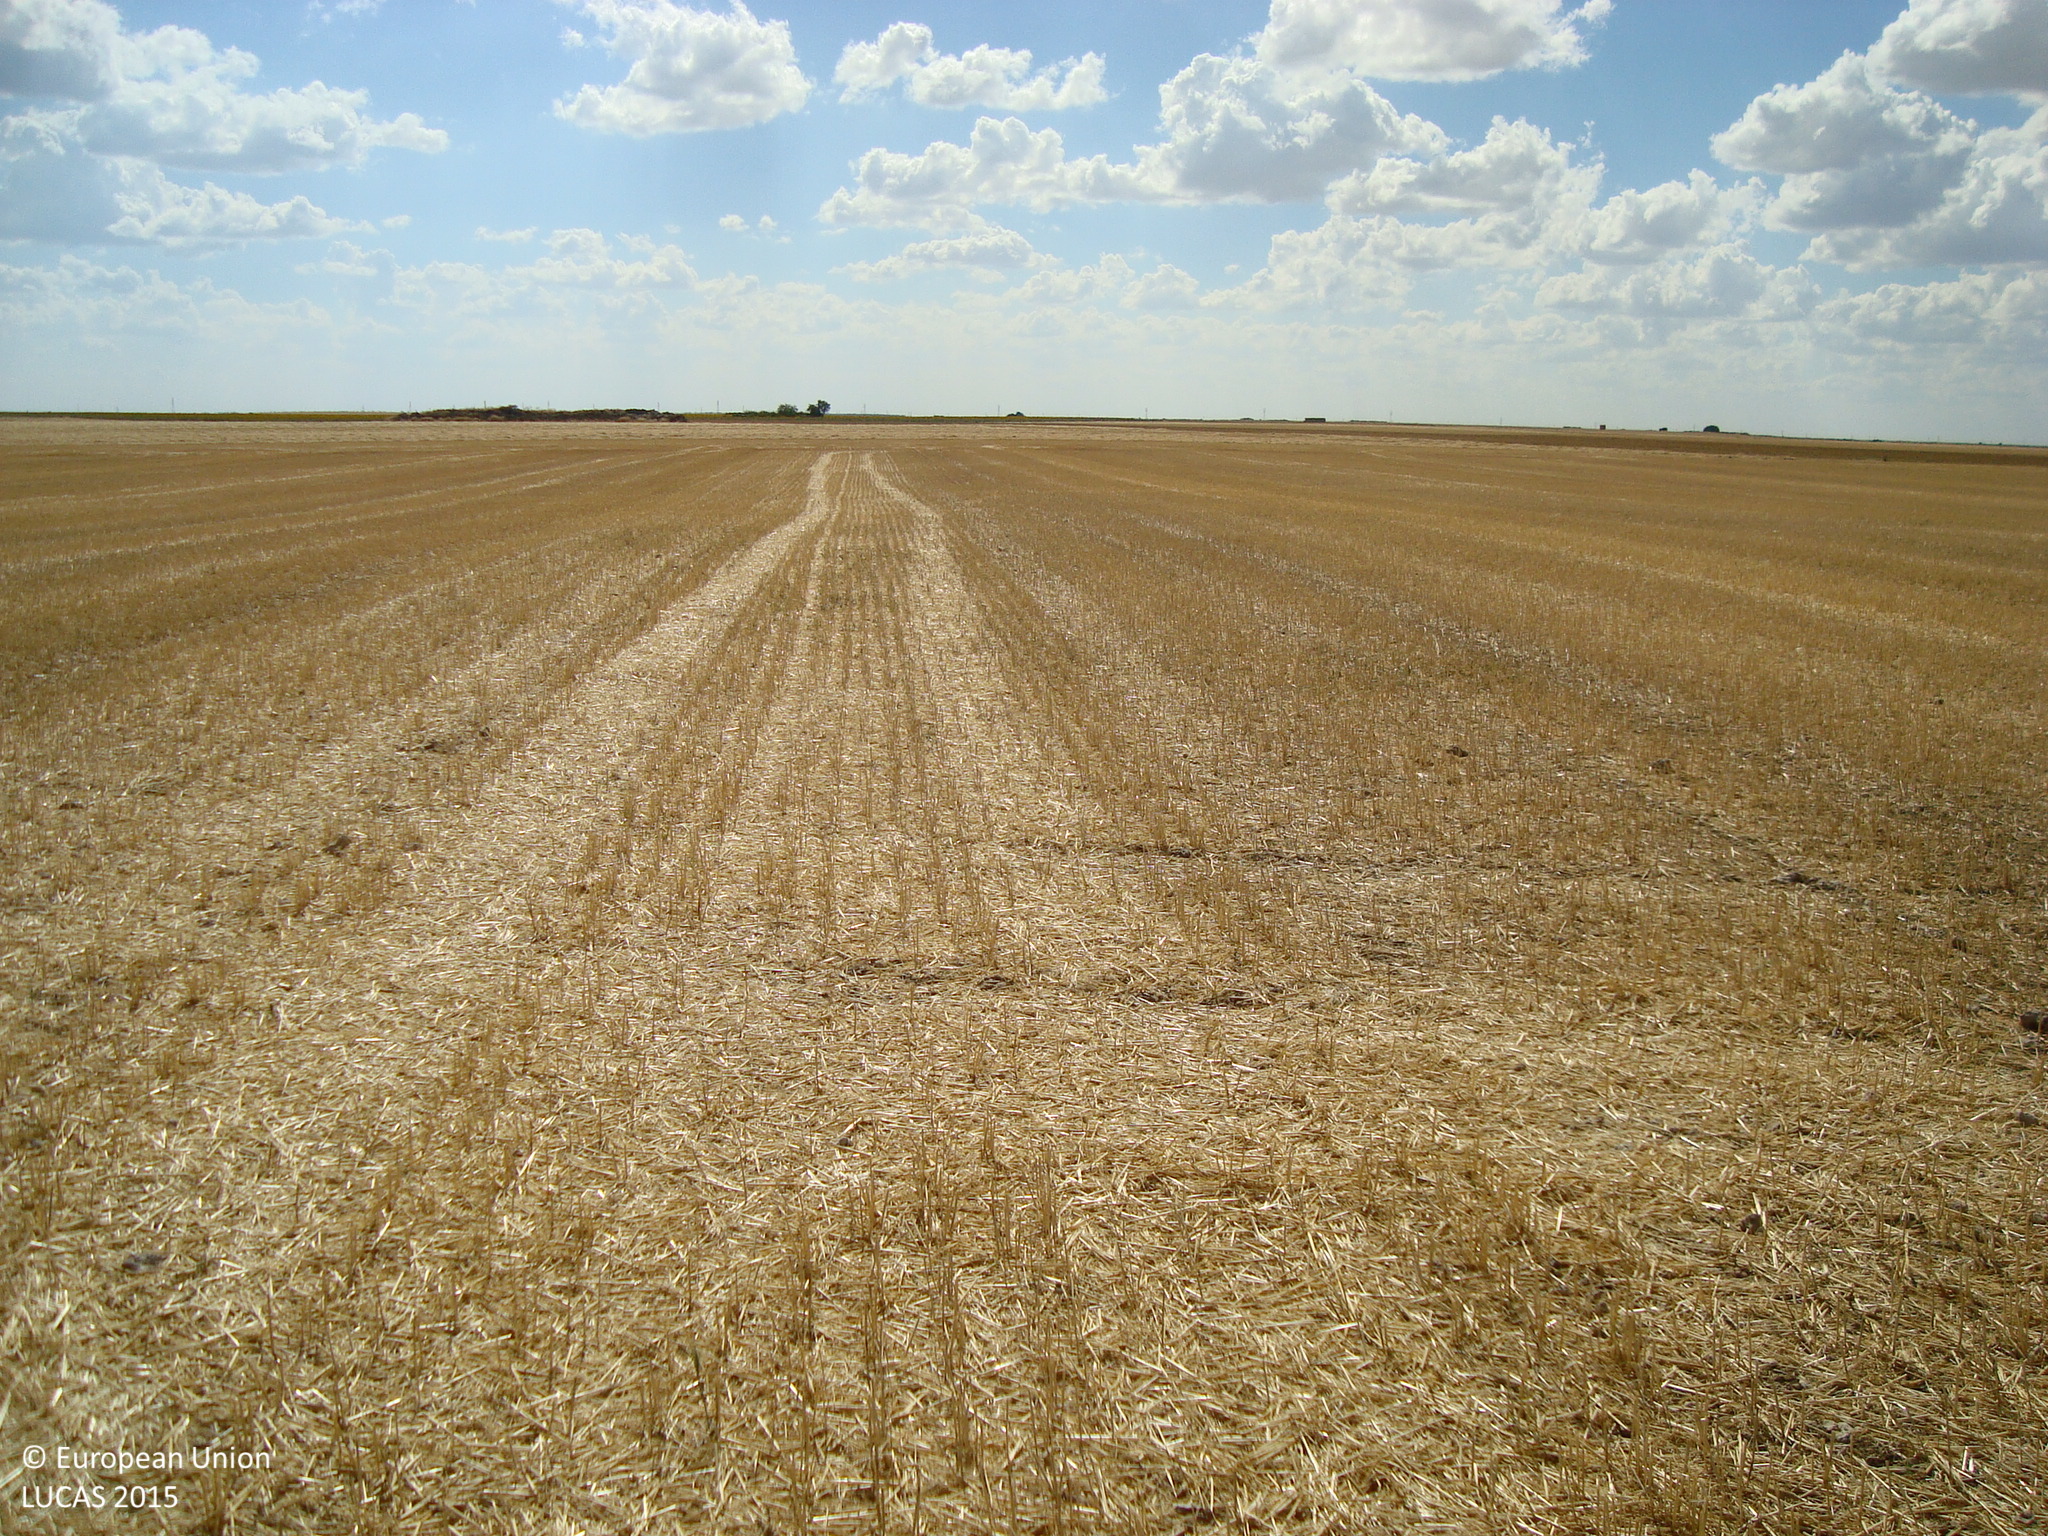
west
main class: Cropland
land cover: Barley
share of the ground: > 75 %
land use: Agriculture (excluding fallow land and kitchen gardens)
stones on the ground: < 10 %
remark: Harvested field
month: July
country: ES
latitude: 41.7189
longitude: -4.0867
